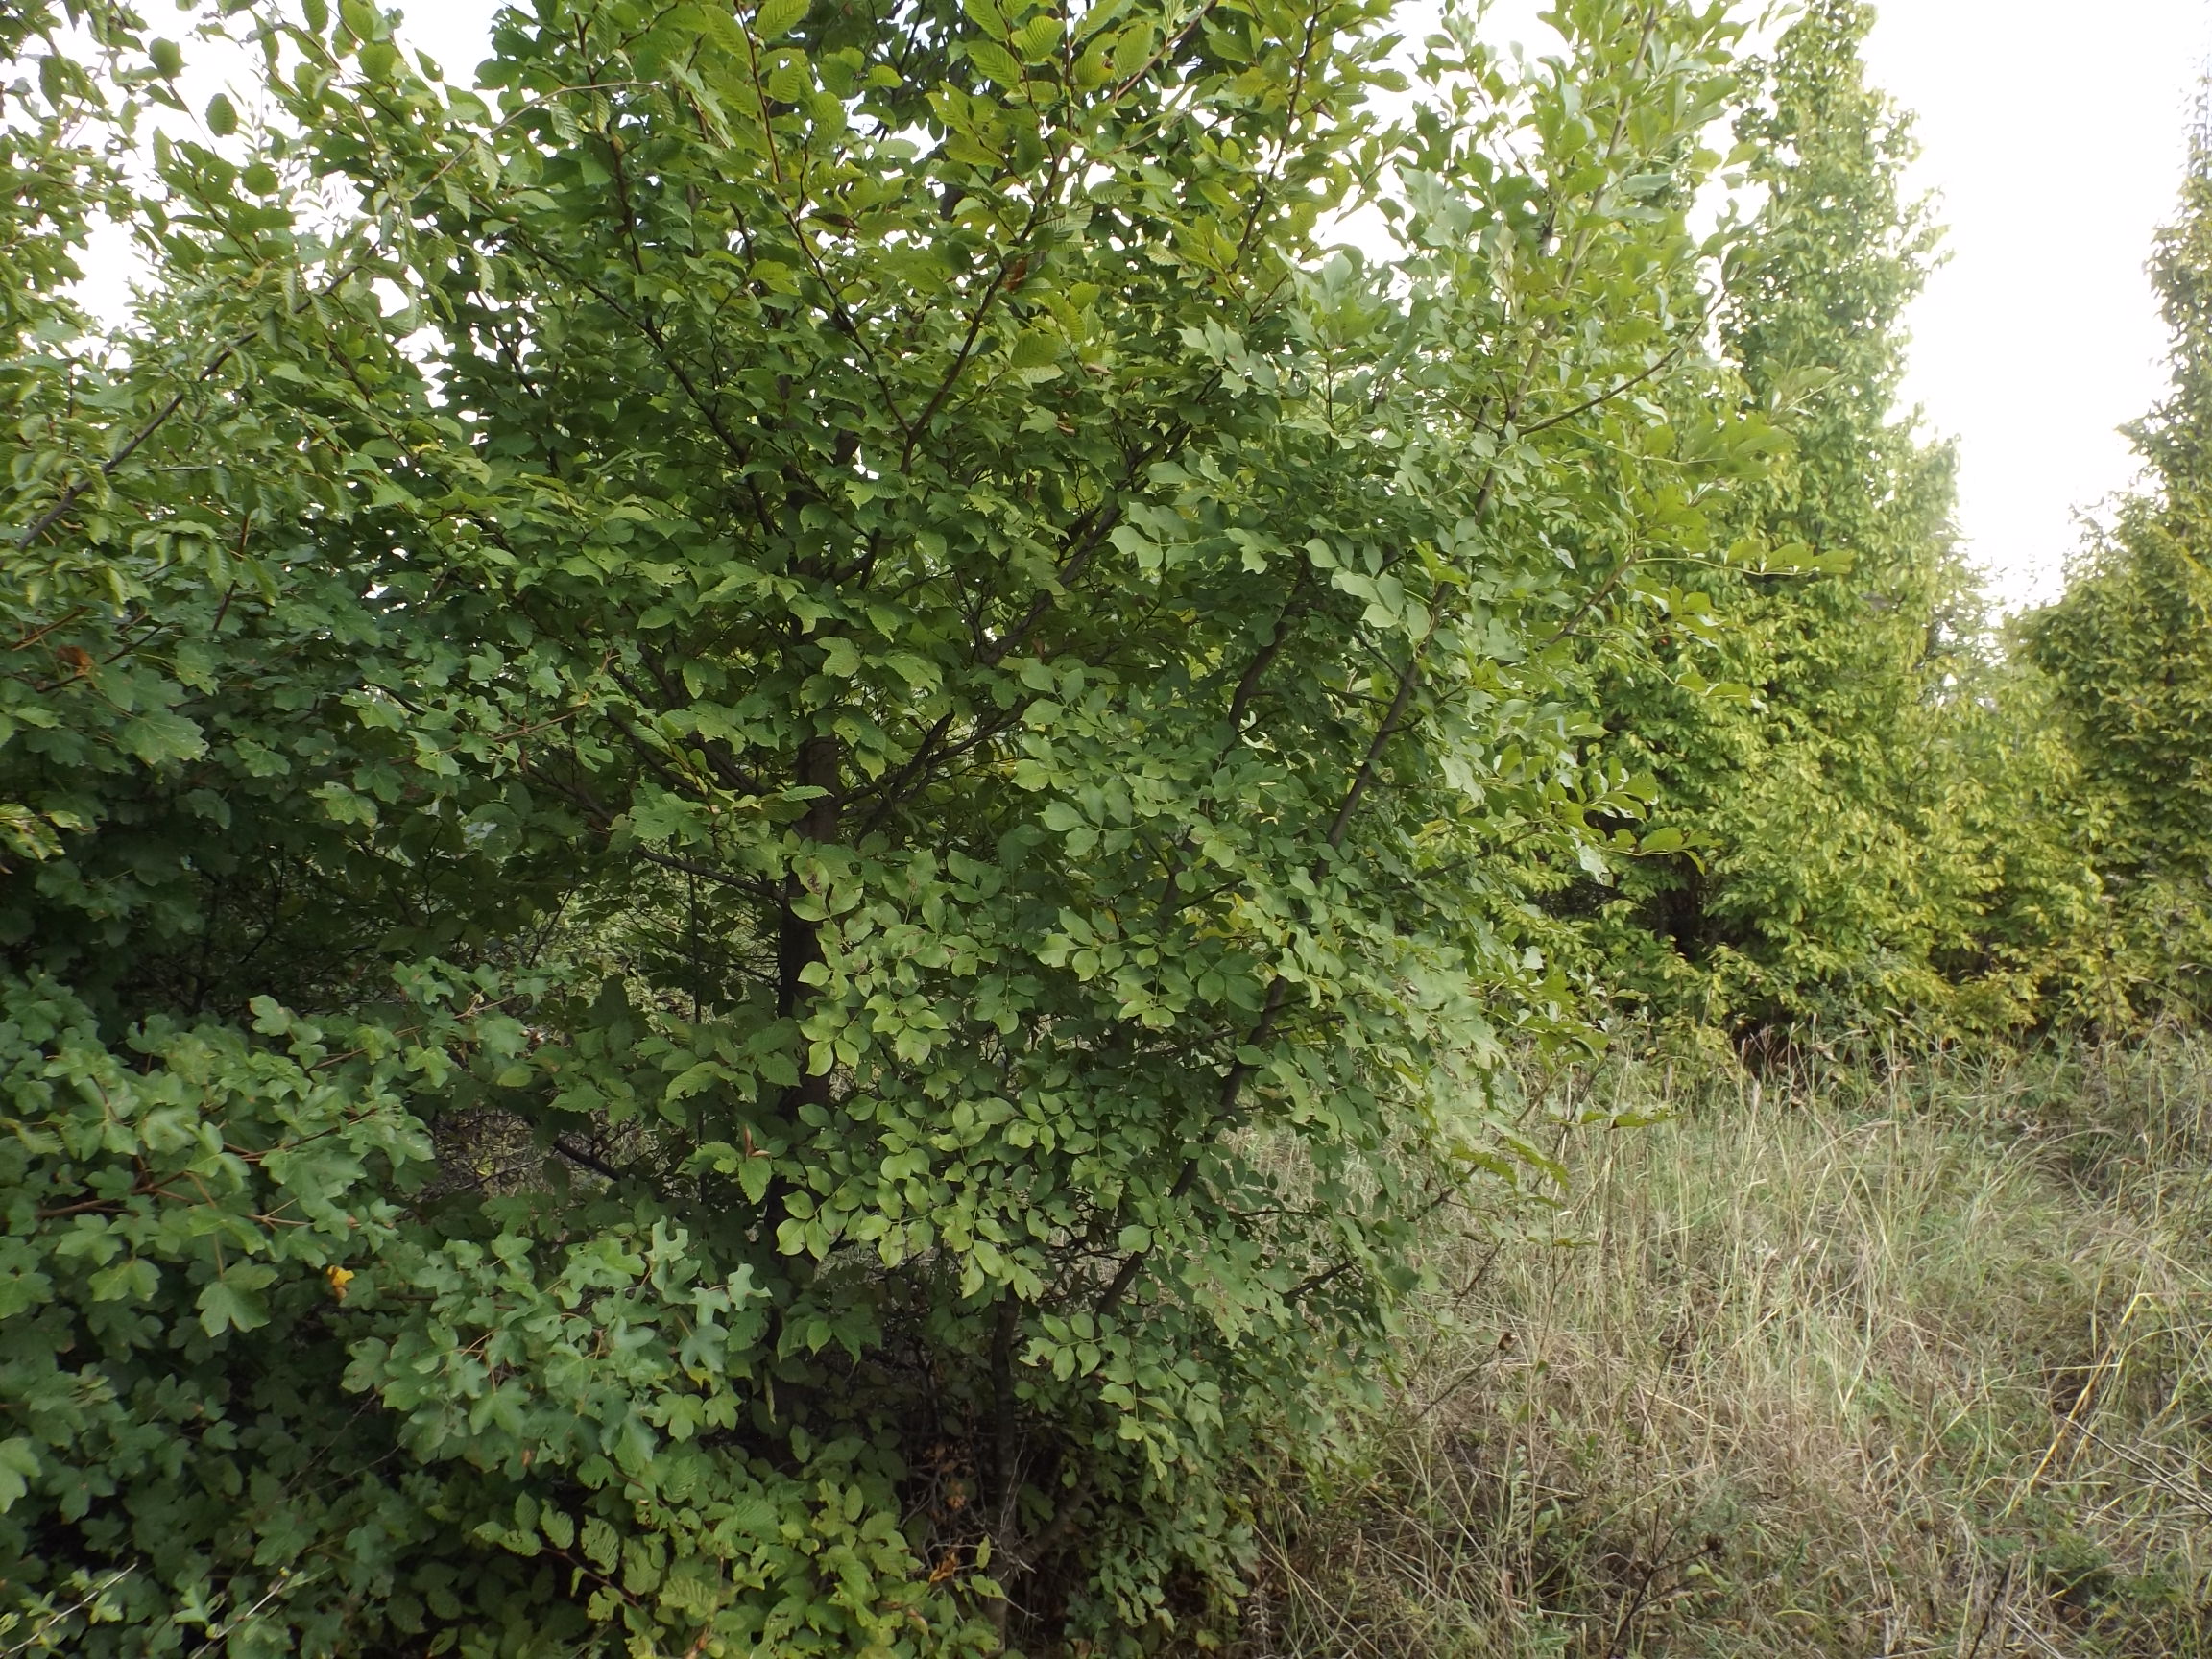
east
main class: Woodland
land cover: Broadleaved woodland
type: mesophytic deciduous forest
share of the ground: > 75 %
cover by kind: broadleaved forest trees 75 %, herbaceous plants 15 %, shrubs 10 %
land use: Forestry
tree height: > 5 m
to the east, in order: Broadleaved woodland; Barley; Shruby margins; Barley
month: September
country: BG
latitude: 43.2949
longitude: 28.0031
